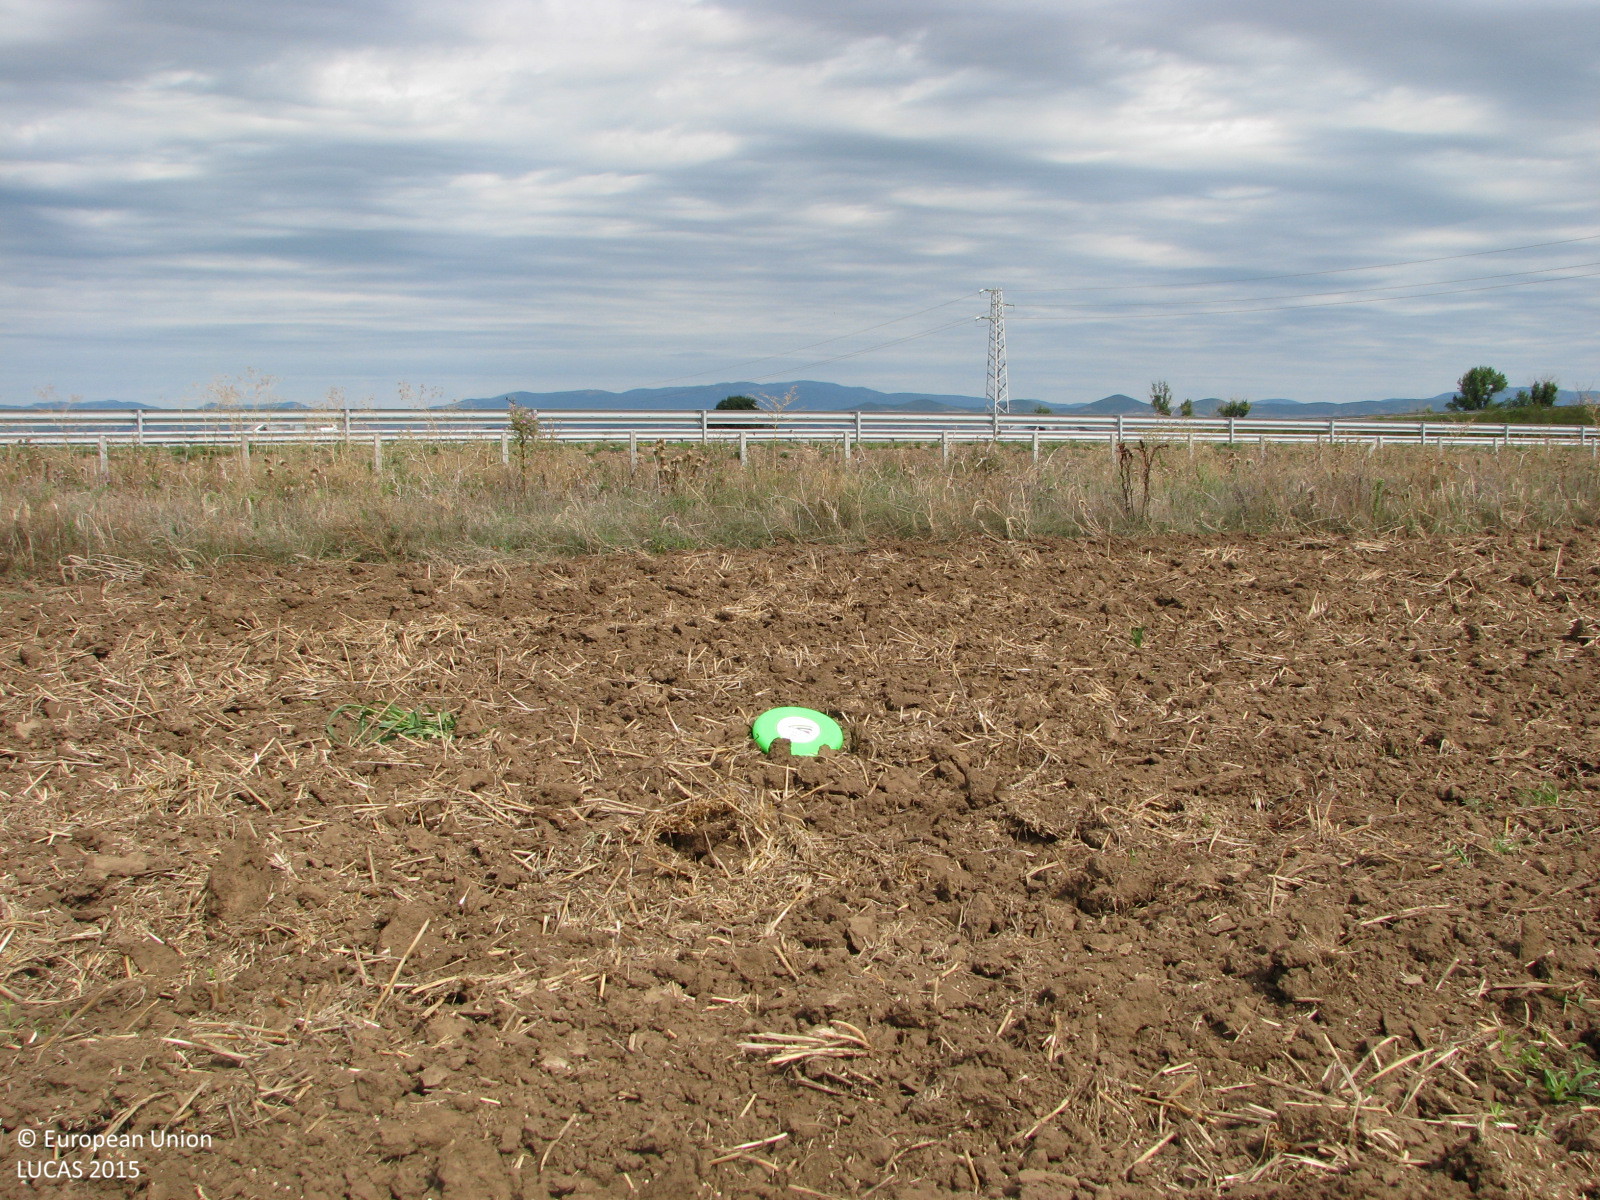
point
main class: Cropland
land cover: Common wheat
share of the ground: < 10 %
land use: Agriculture (excluding fallow land and kitchen gardens)
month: September
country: BG
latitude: 42.4492
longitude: 26.0455
